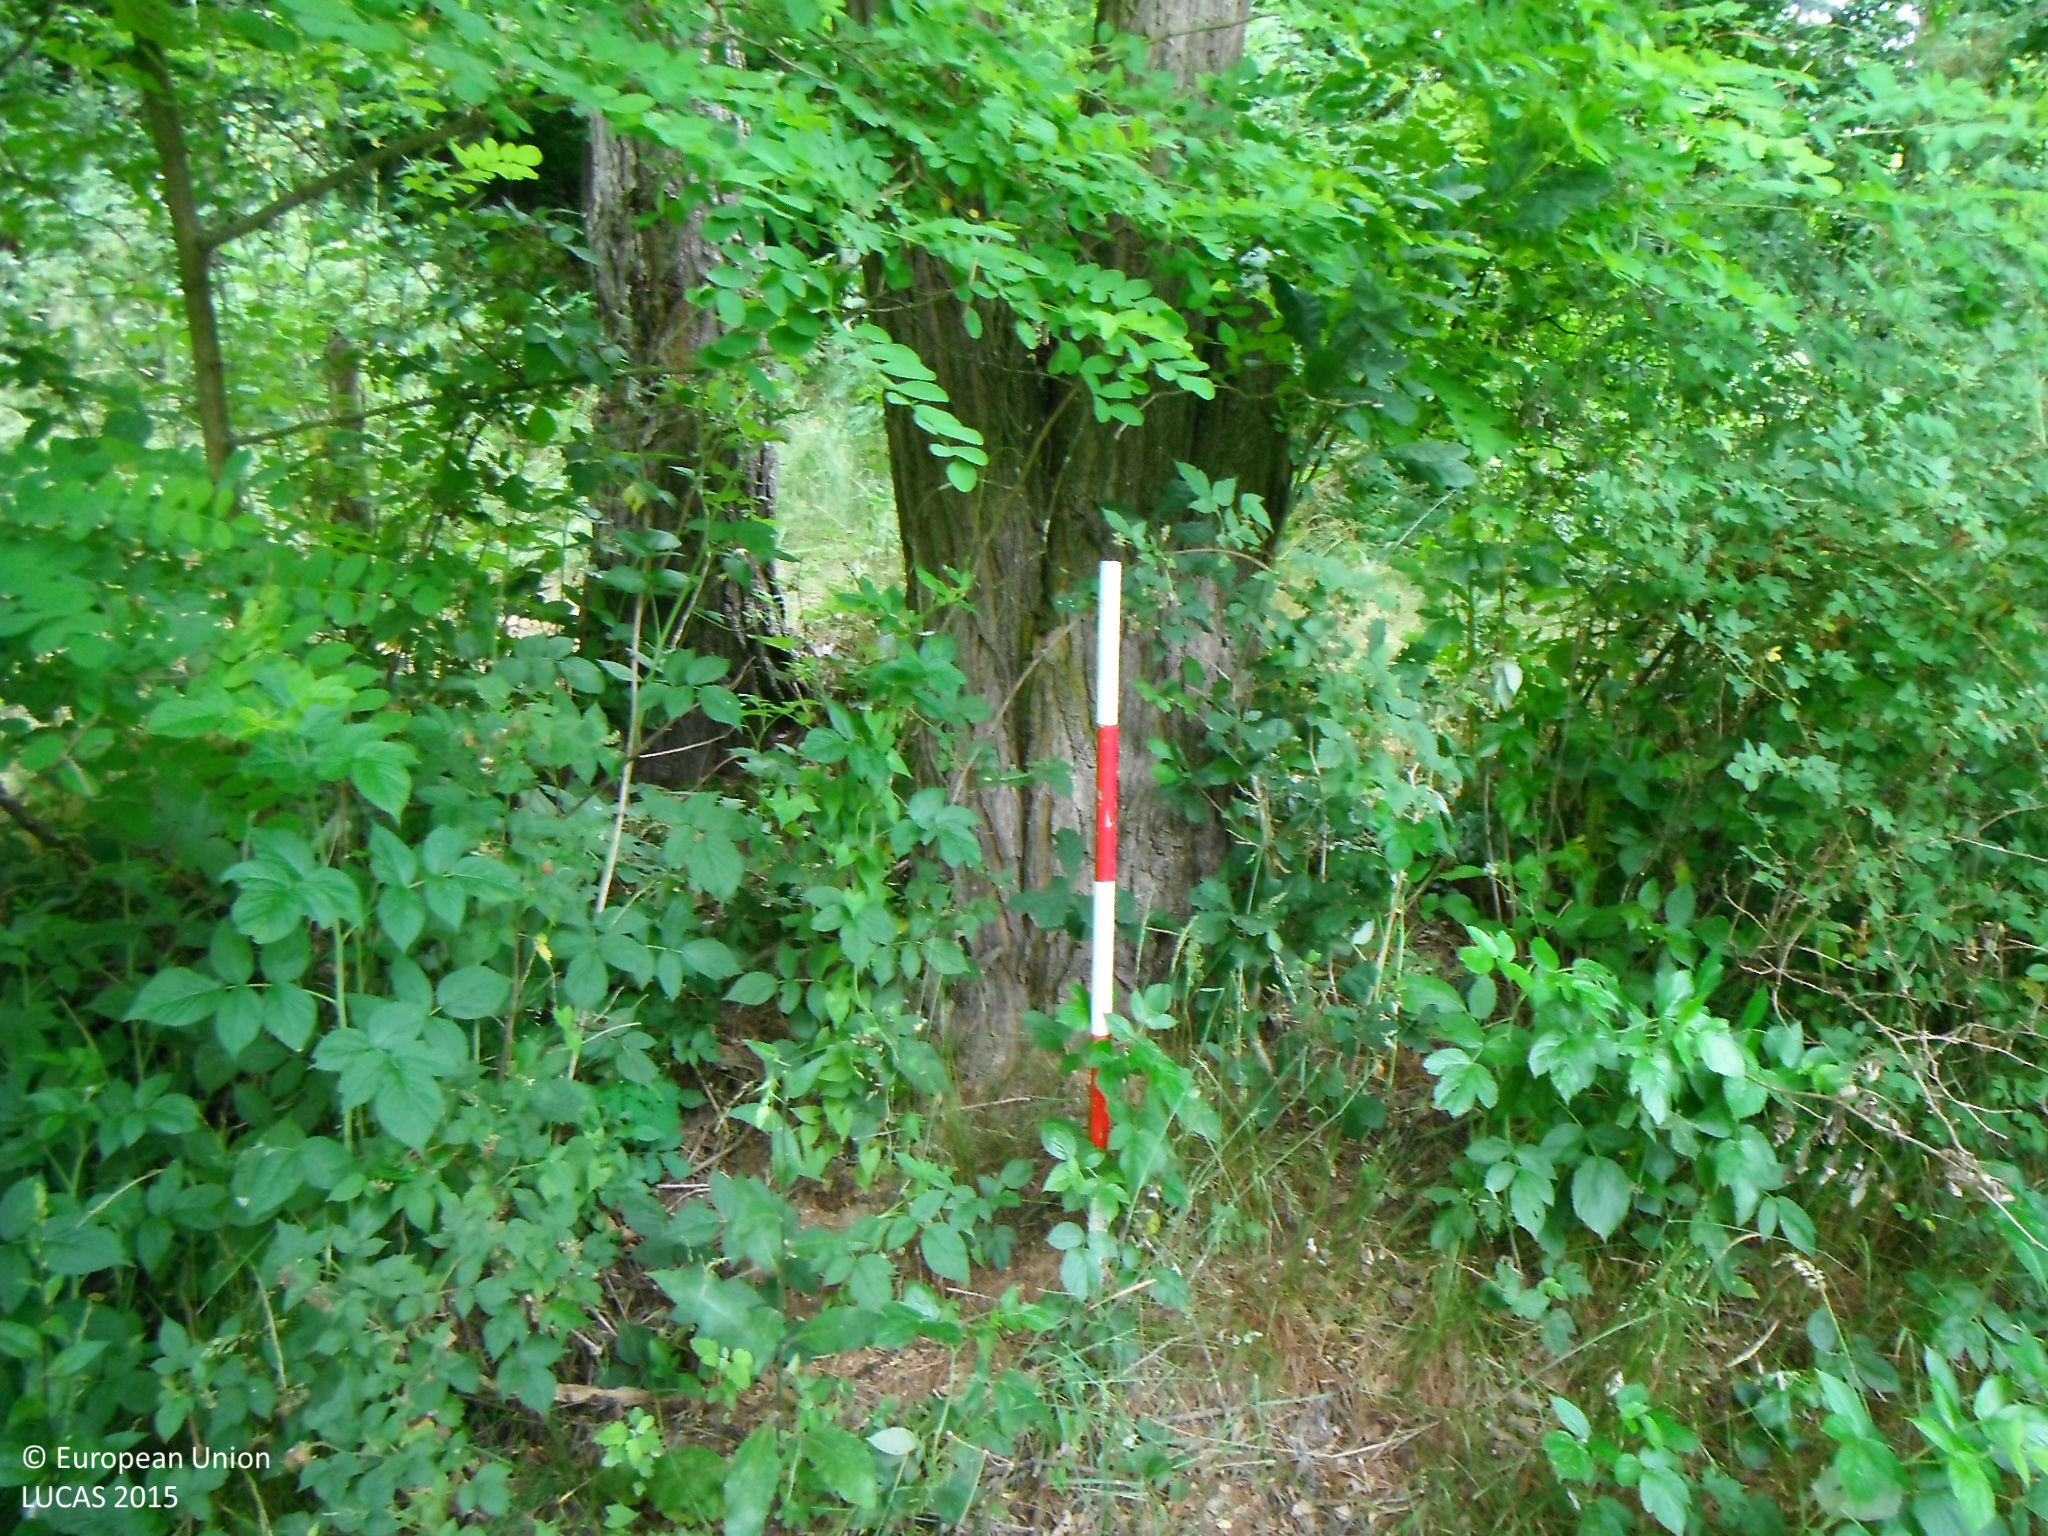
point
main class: Woodland
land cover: Broadleaved woodland
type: exotic forest
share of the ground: > 75 %
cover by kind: broadleaved forest trees 80 %, shrubs 10 %, herbaceous plants 10 %
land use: Forestry
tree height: > 5 m
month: June
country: SK
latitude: 48.5793
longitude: 20.0473
